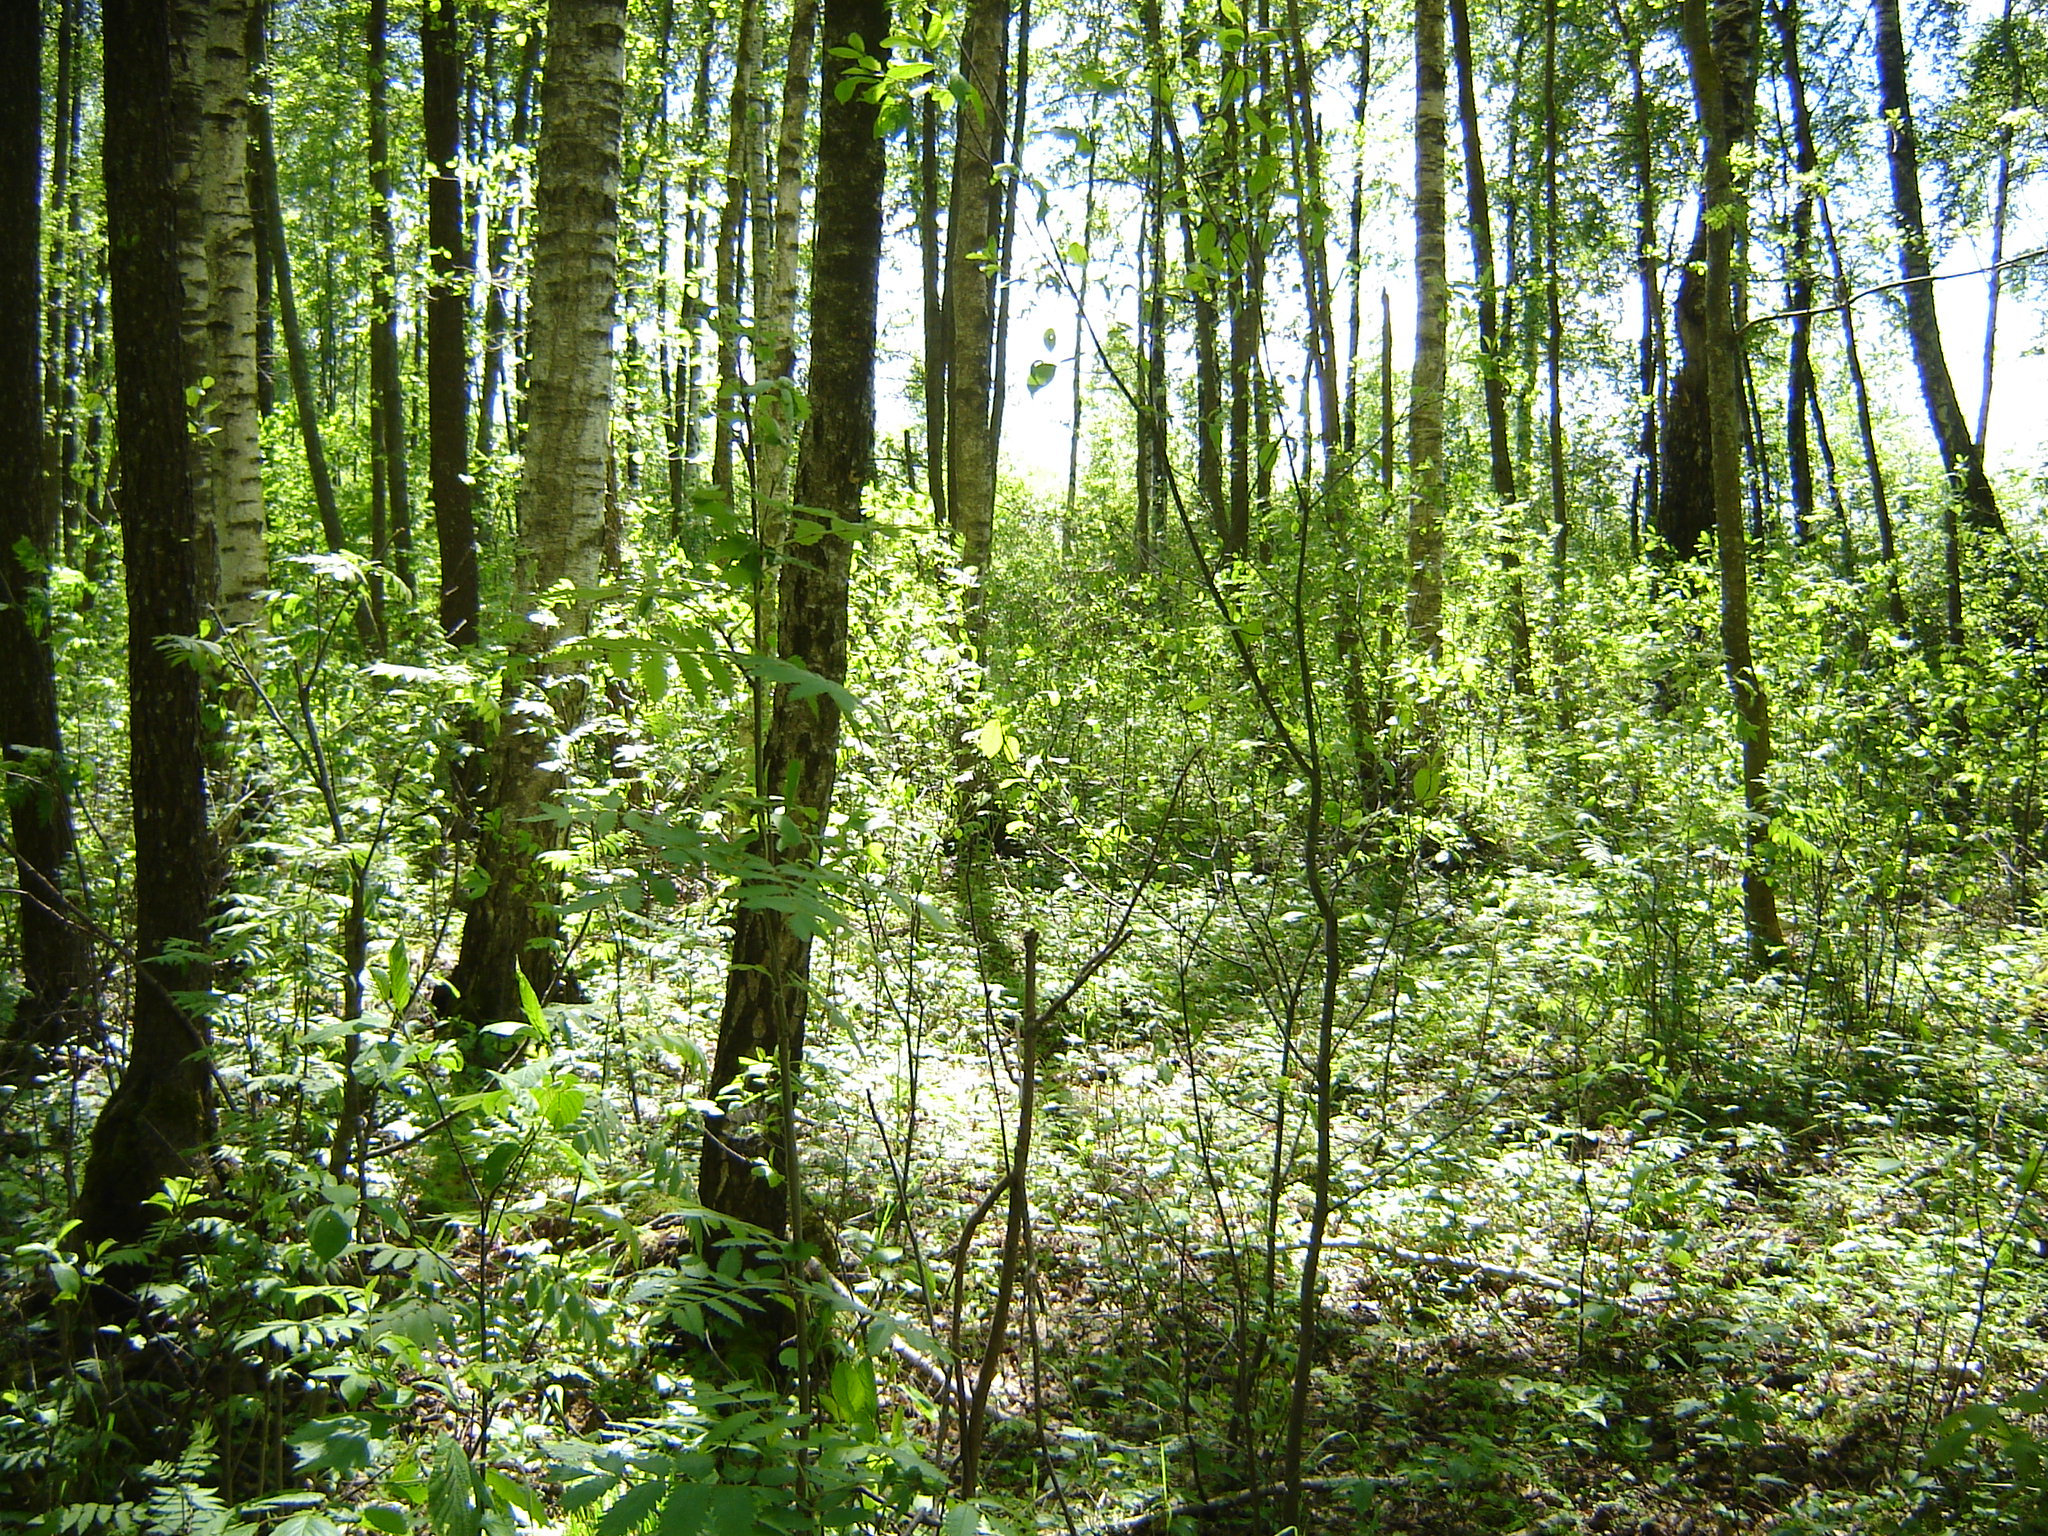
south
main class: Woodland
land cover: Broadleaved woodland
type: non-riverine alder, birch or aspen forest
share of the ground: > 75 %
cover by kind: broadleaved forest trees 95 %, herbaceous plants 5 %
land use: Forestry
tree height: > 5 m
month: May
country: LT
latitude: 55.8421
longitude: 25.2068
